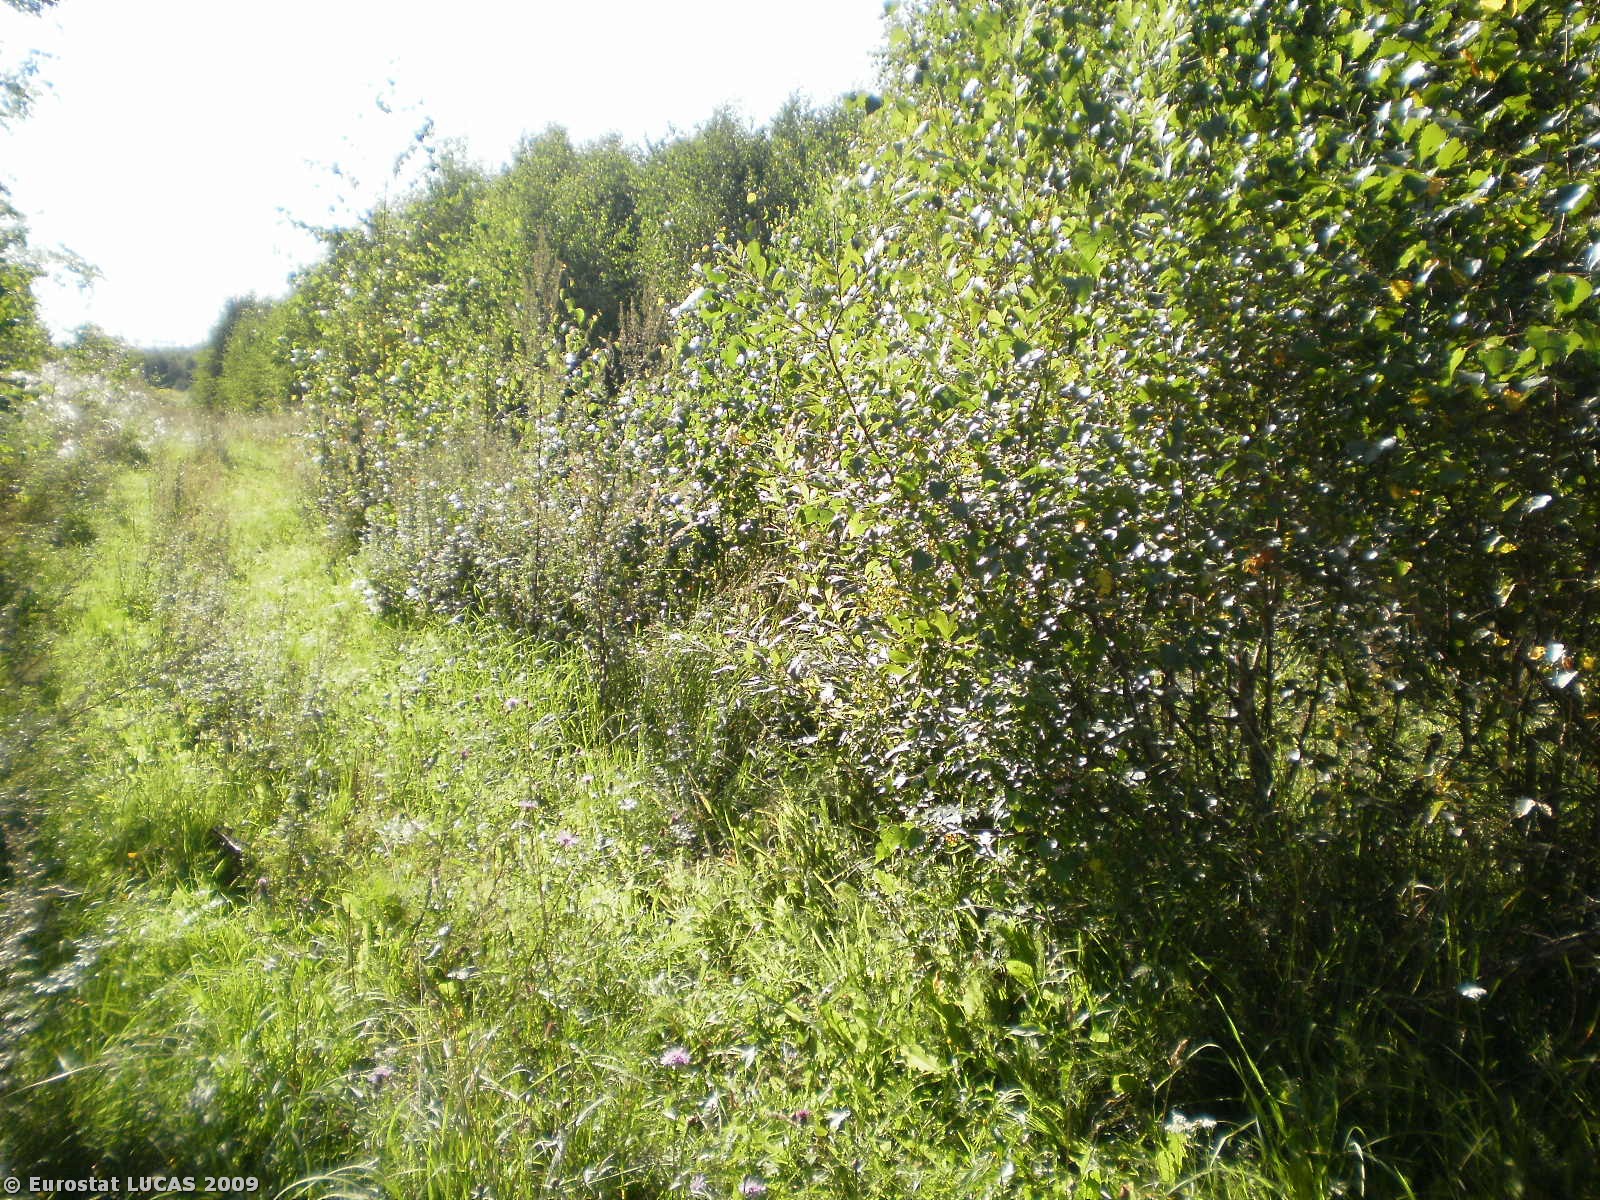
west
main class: Grassland
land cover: Grassland with sparse tree/shrub cover
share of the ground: > 75 %
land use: Unused
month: August
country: PL
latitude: 54.0802
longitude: 21.1878
